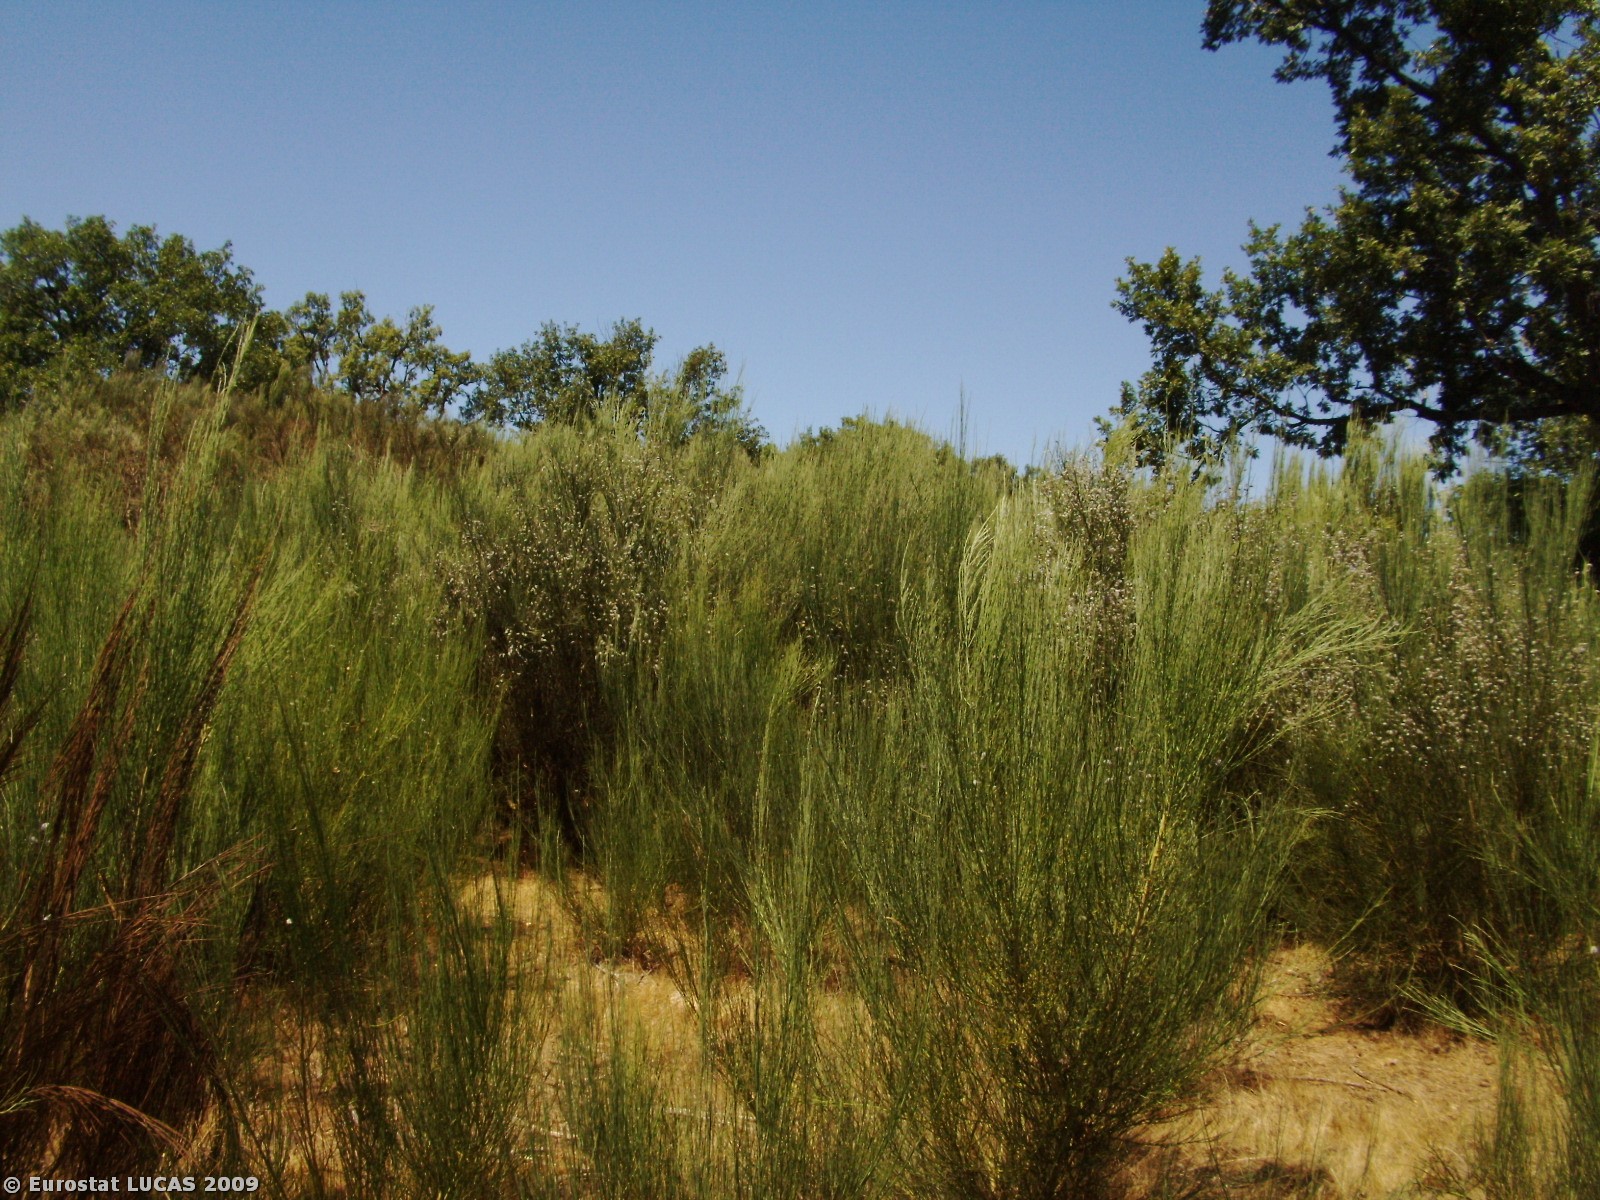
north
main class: Shrubland
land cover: Shrubland with sparse tree cover
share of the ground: > 75 %
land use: Forestry
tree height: > 5 m
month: July
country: PT
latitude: 40.5366
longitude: -7.2358
